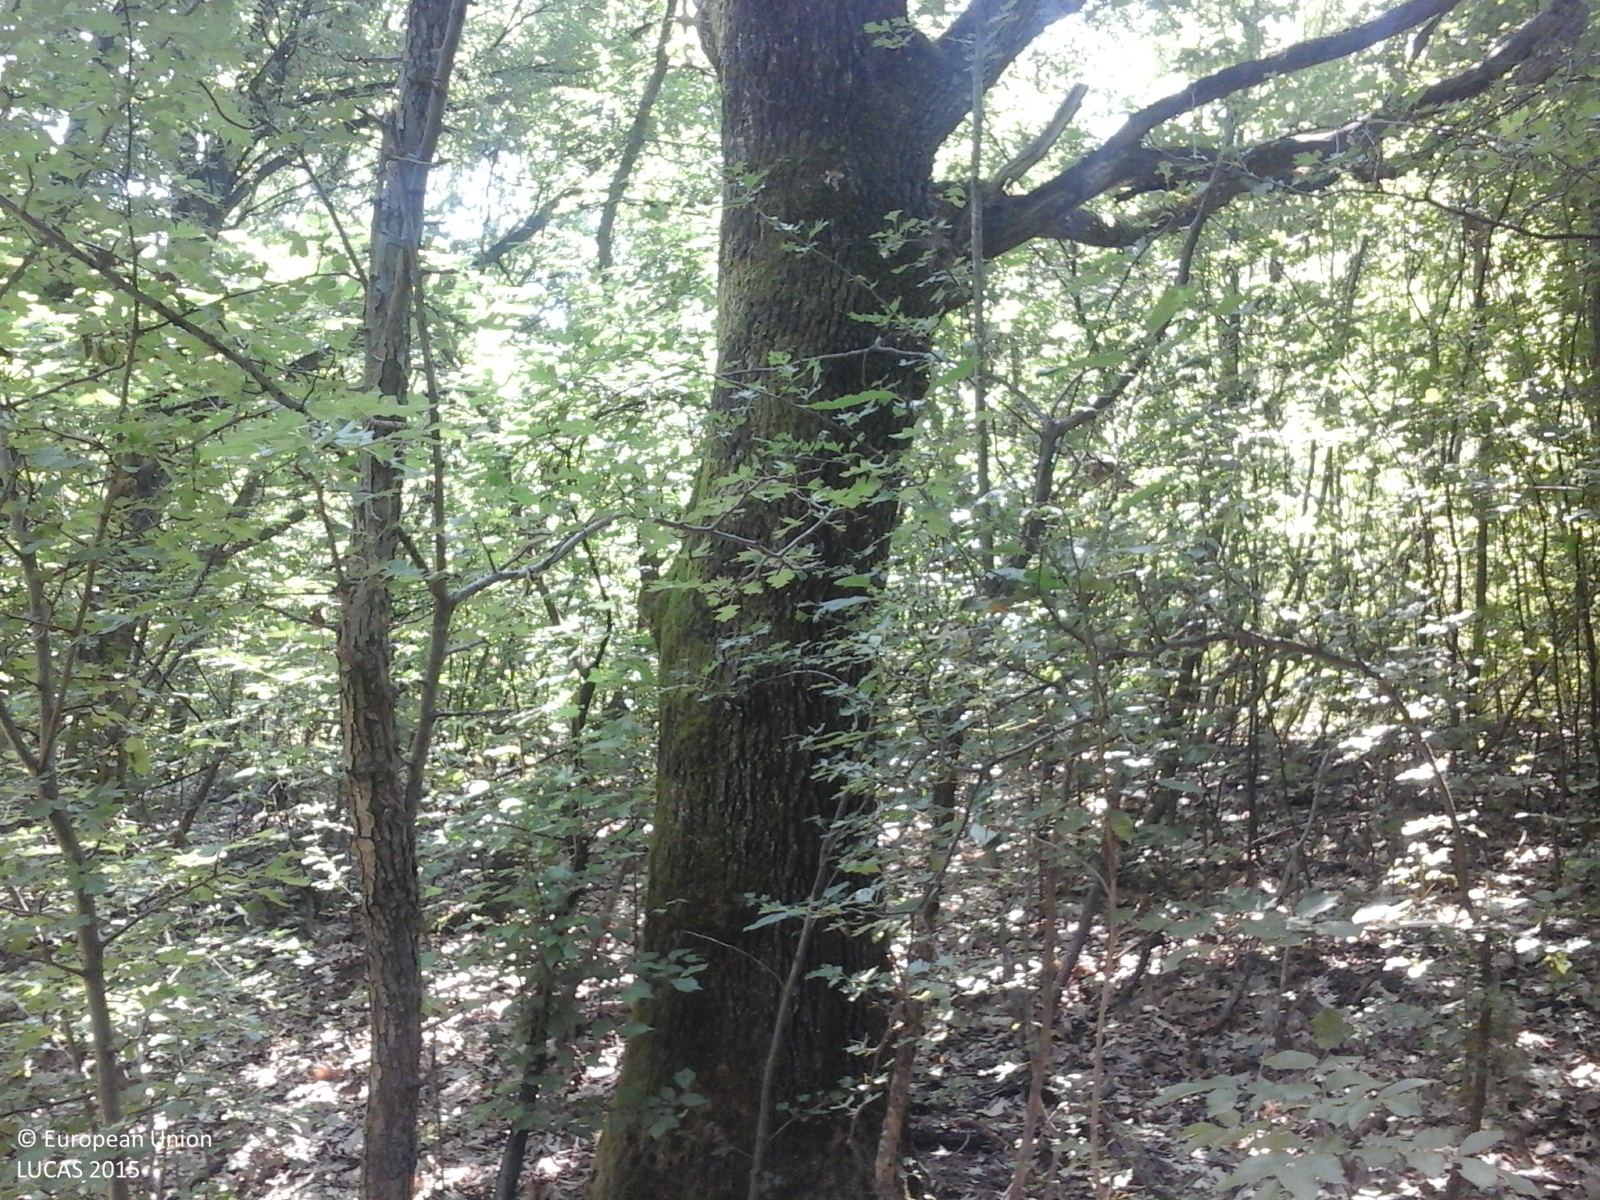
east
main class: Woodland
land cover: Broadleaved woodland
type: beech forest
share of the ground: > 75 %
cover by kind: broadleaved forest trees 100 %
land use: Forestry
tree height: > 5 m
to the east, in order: Broadleaved woodland; Tracks; Grassland with sparse tree/shrub cover
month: July
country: RO
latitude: 44.7336
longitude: 24.3777
